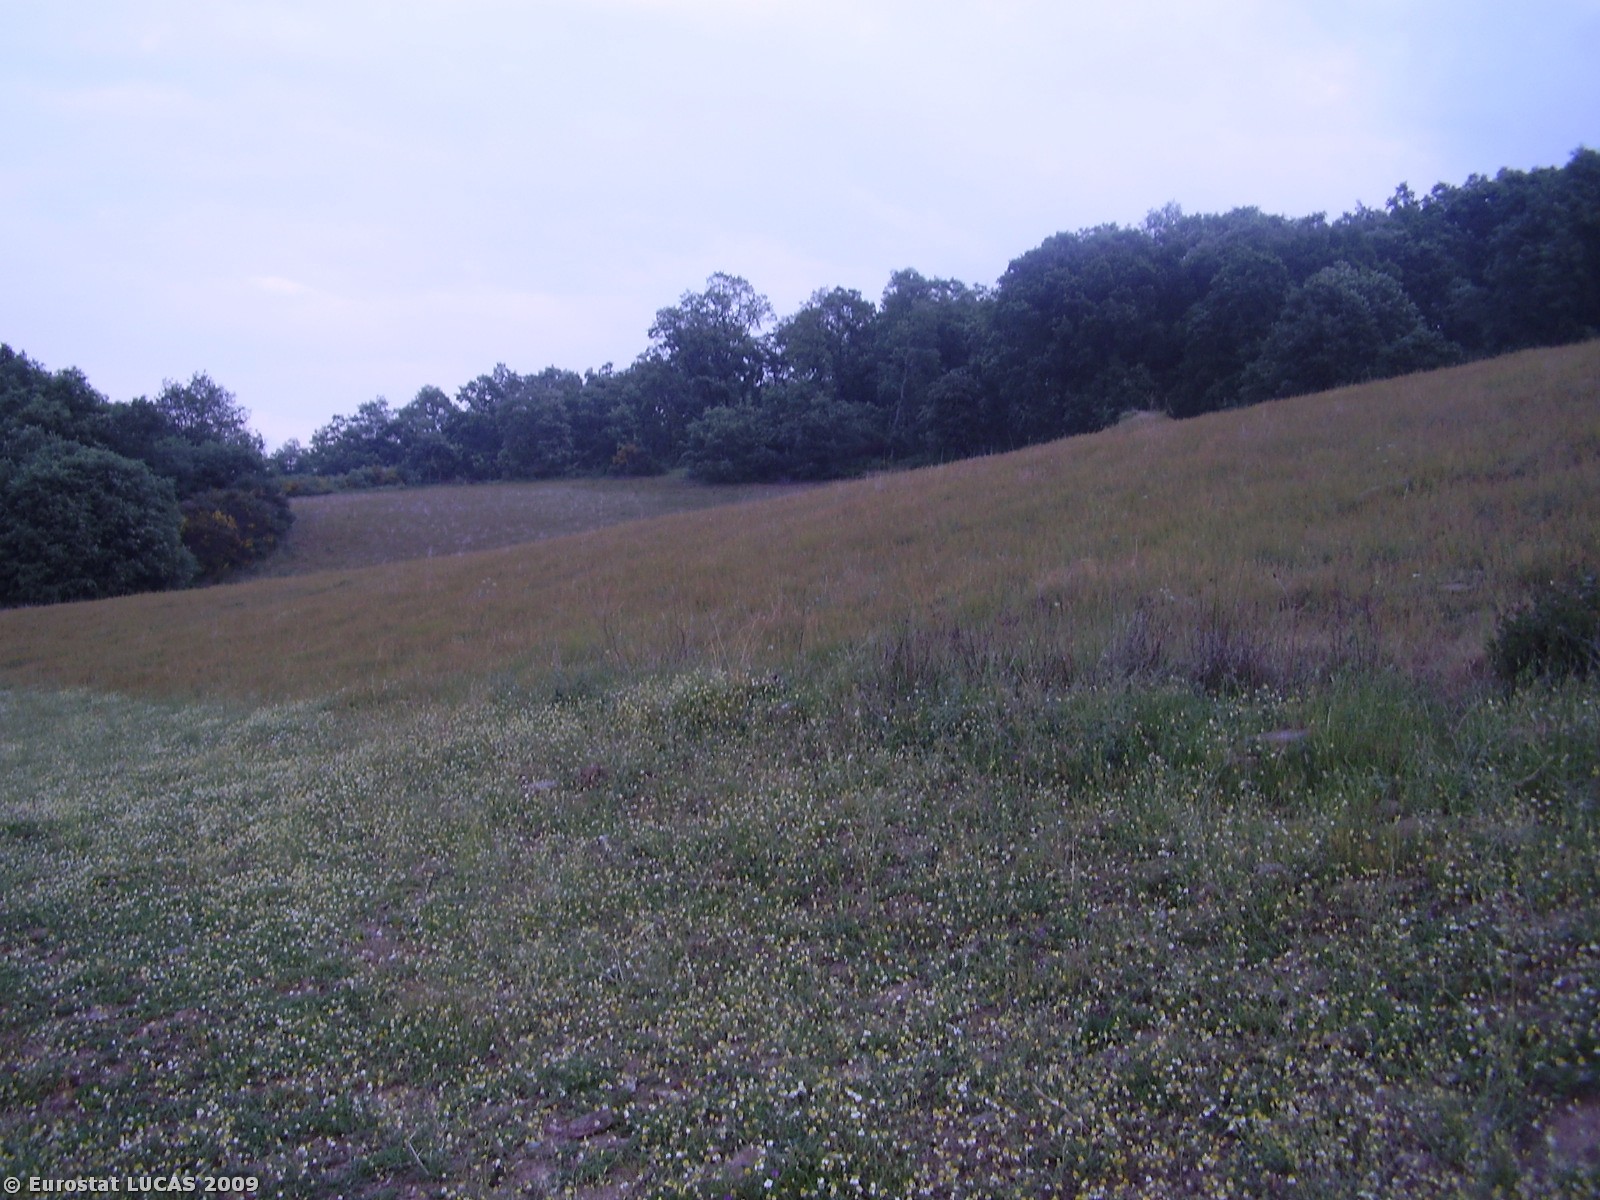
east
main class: Grassland
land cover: Grassland without tree/shrub cover
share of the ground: > 75 %
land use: Forestry
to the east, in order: Grassland without tree/shrub cover; Broadleaved woodland; Tracks; Broadleaved woodland
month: June
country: PT
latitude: 41.6595
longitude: -6.8170
